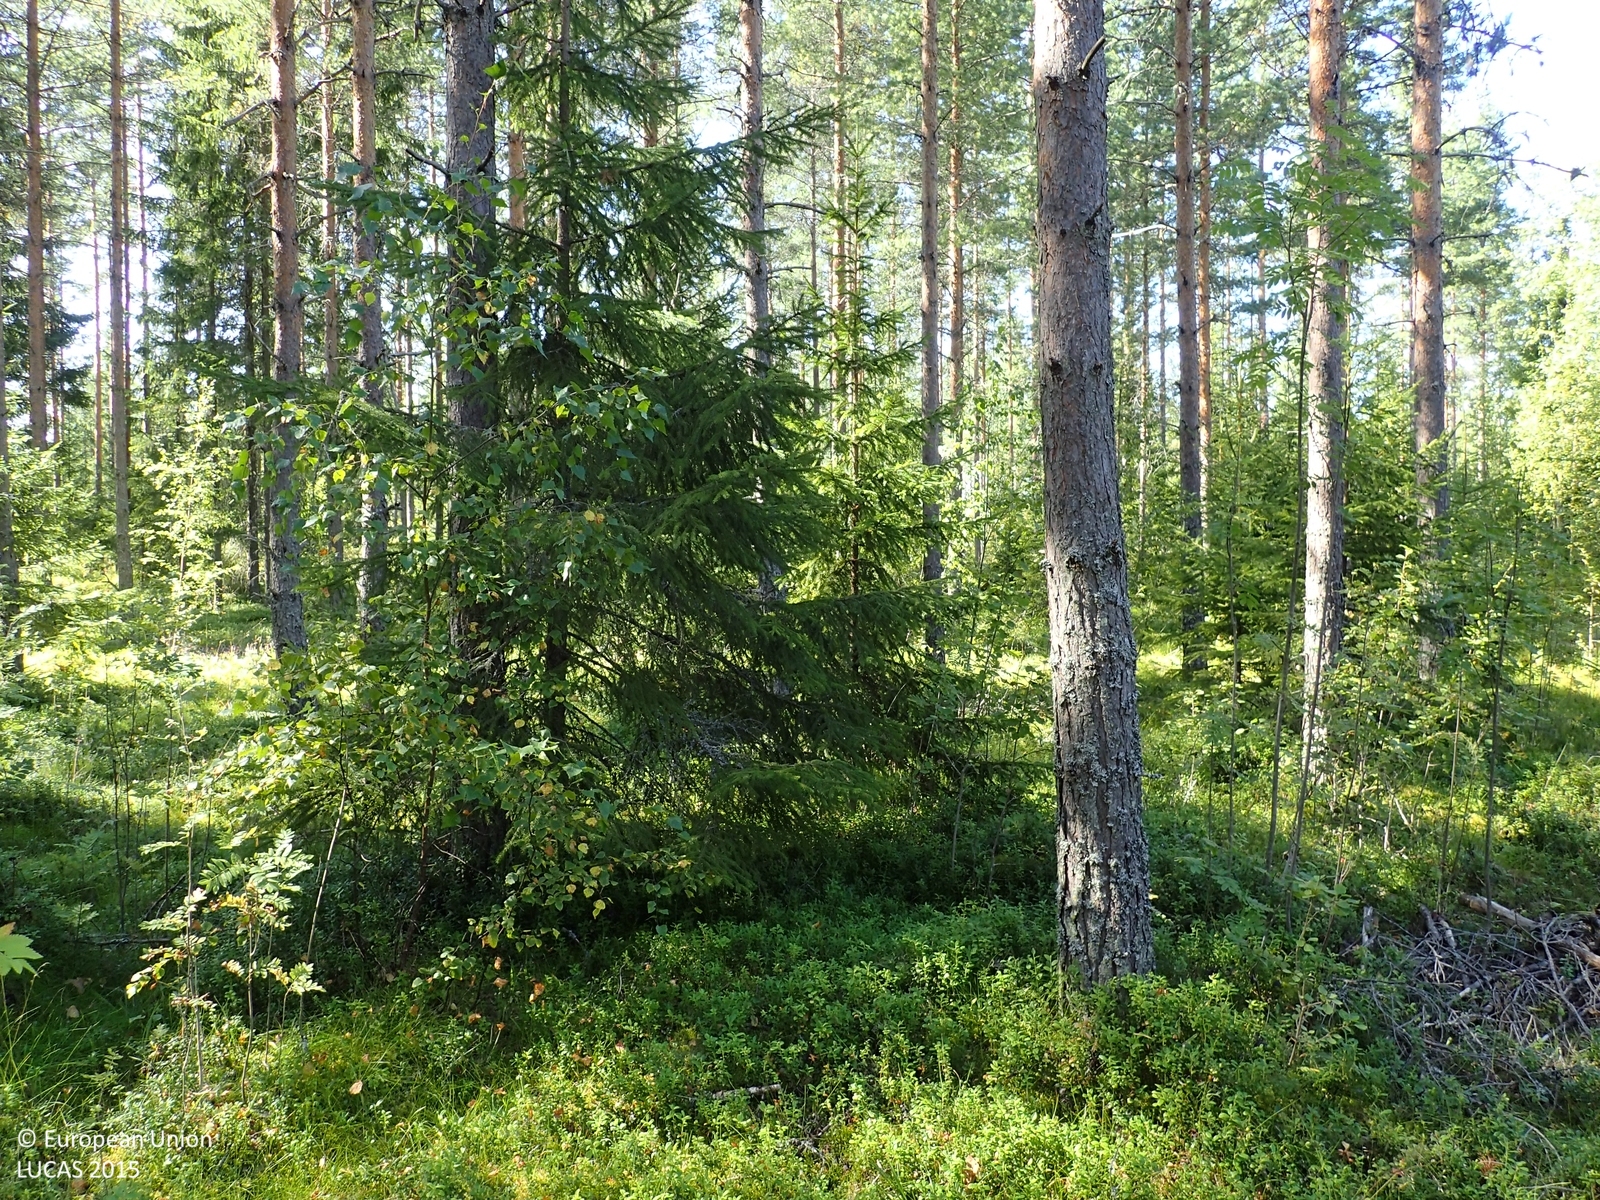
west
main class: Woodland
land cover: Pine dominated coniferous woodland
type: boreal forest
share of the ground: > 75 %
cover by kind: coniferous forest trees 70 %, shrubs 20 %, broadleaved forest trees 5 %, herbaceous plants 5 %
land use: Forestry
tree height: > 5 m
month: August
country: FI
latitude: 62.5863
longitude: 21.7856
